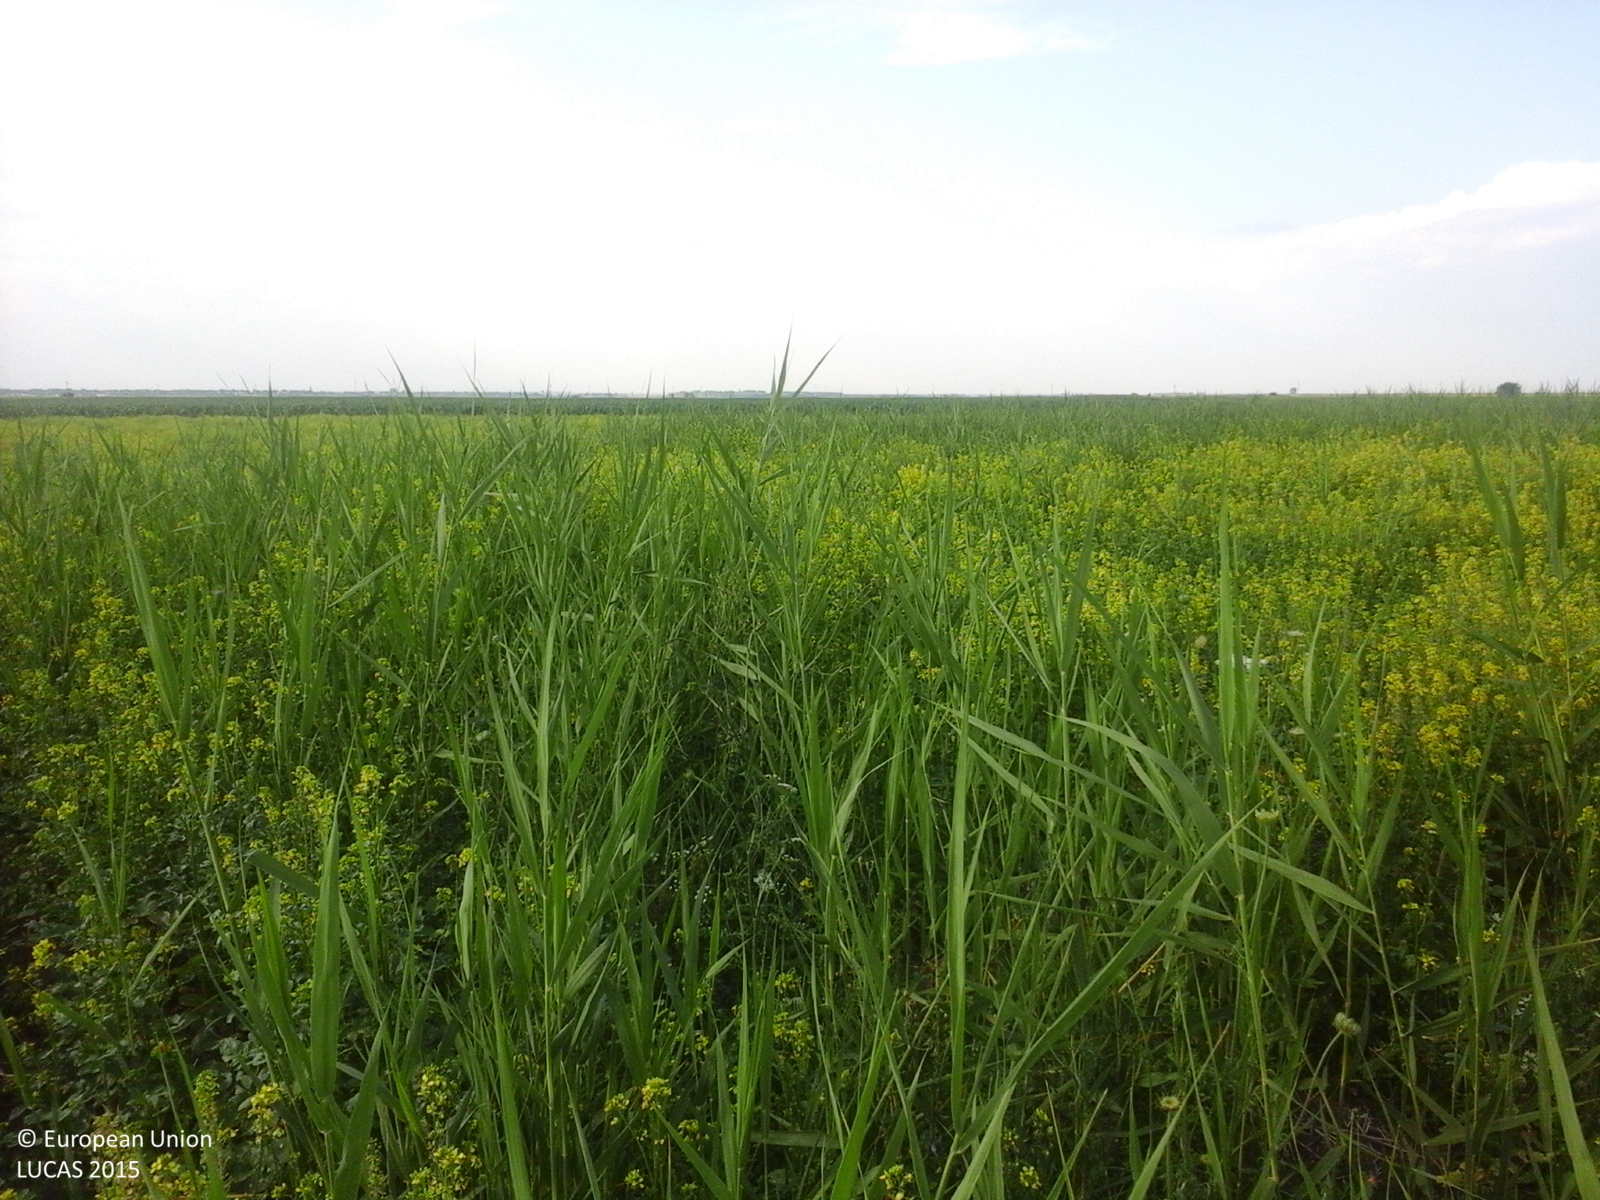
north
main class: Cropland
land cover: Other fibre and oleaginous crops
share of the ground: > 75 %
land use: Agriculture (excluding fallow land and kitchen gardens)
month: July
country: RO
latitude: 43.7546
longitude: 25.8020
